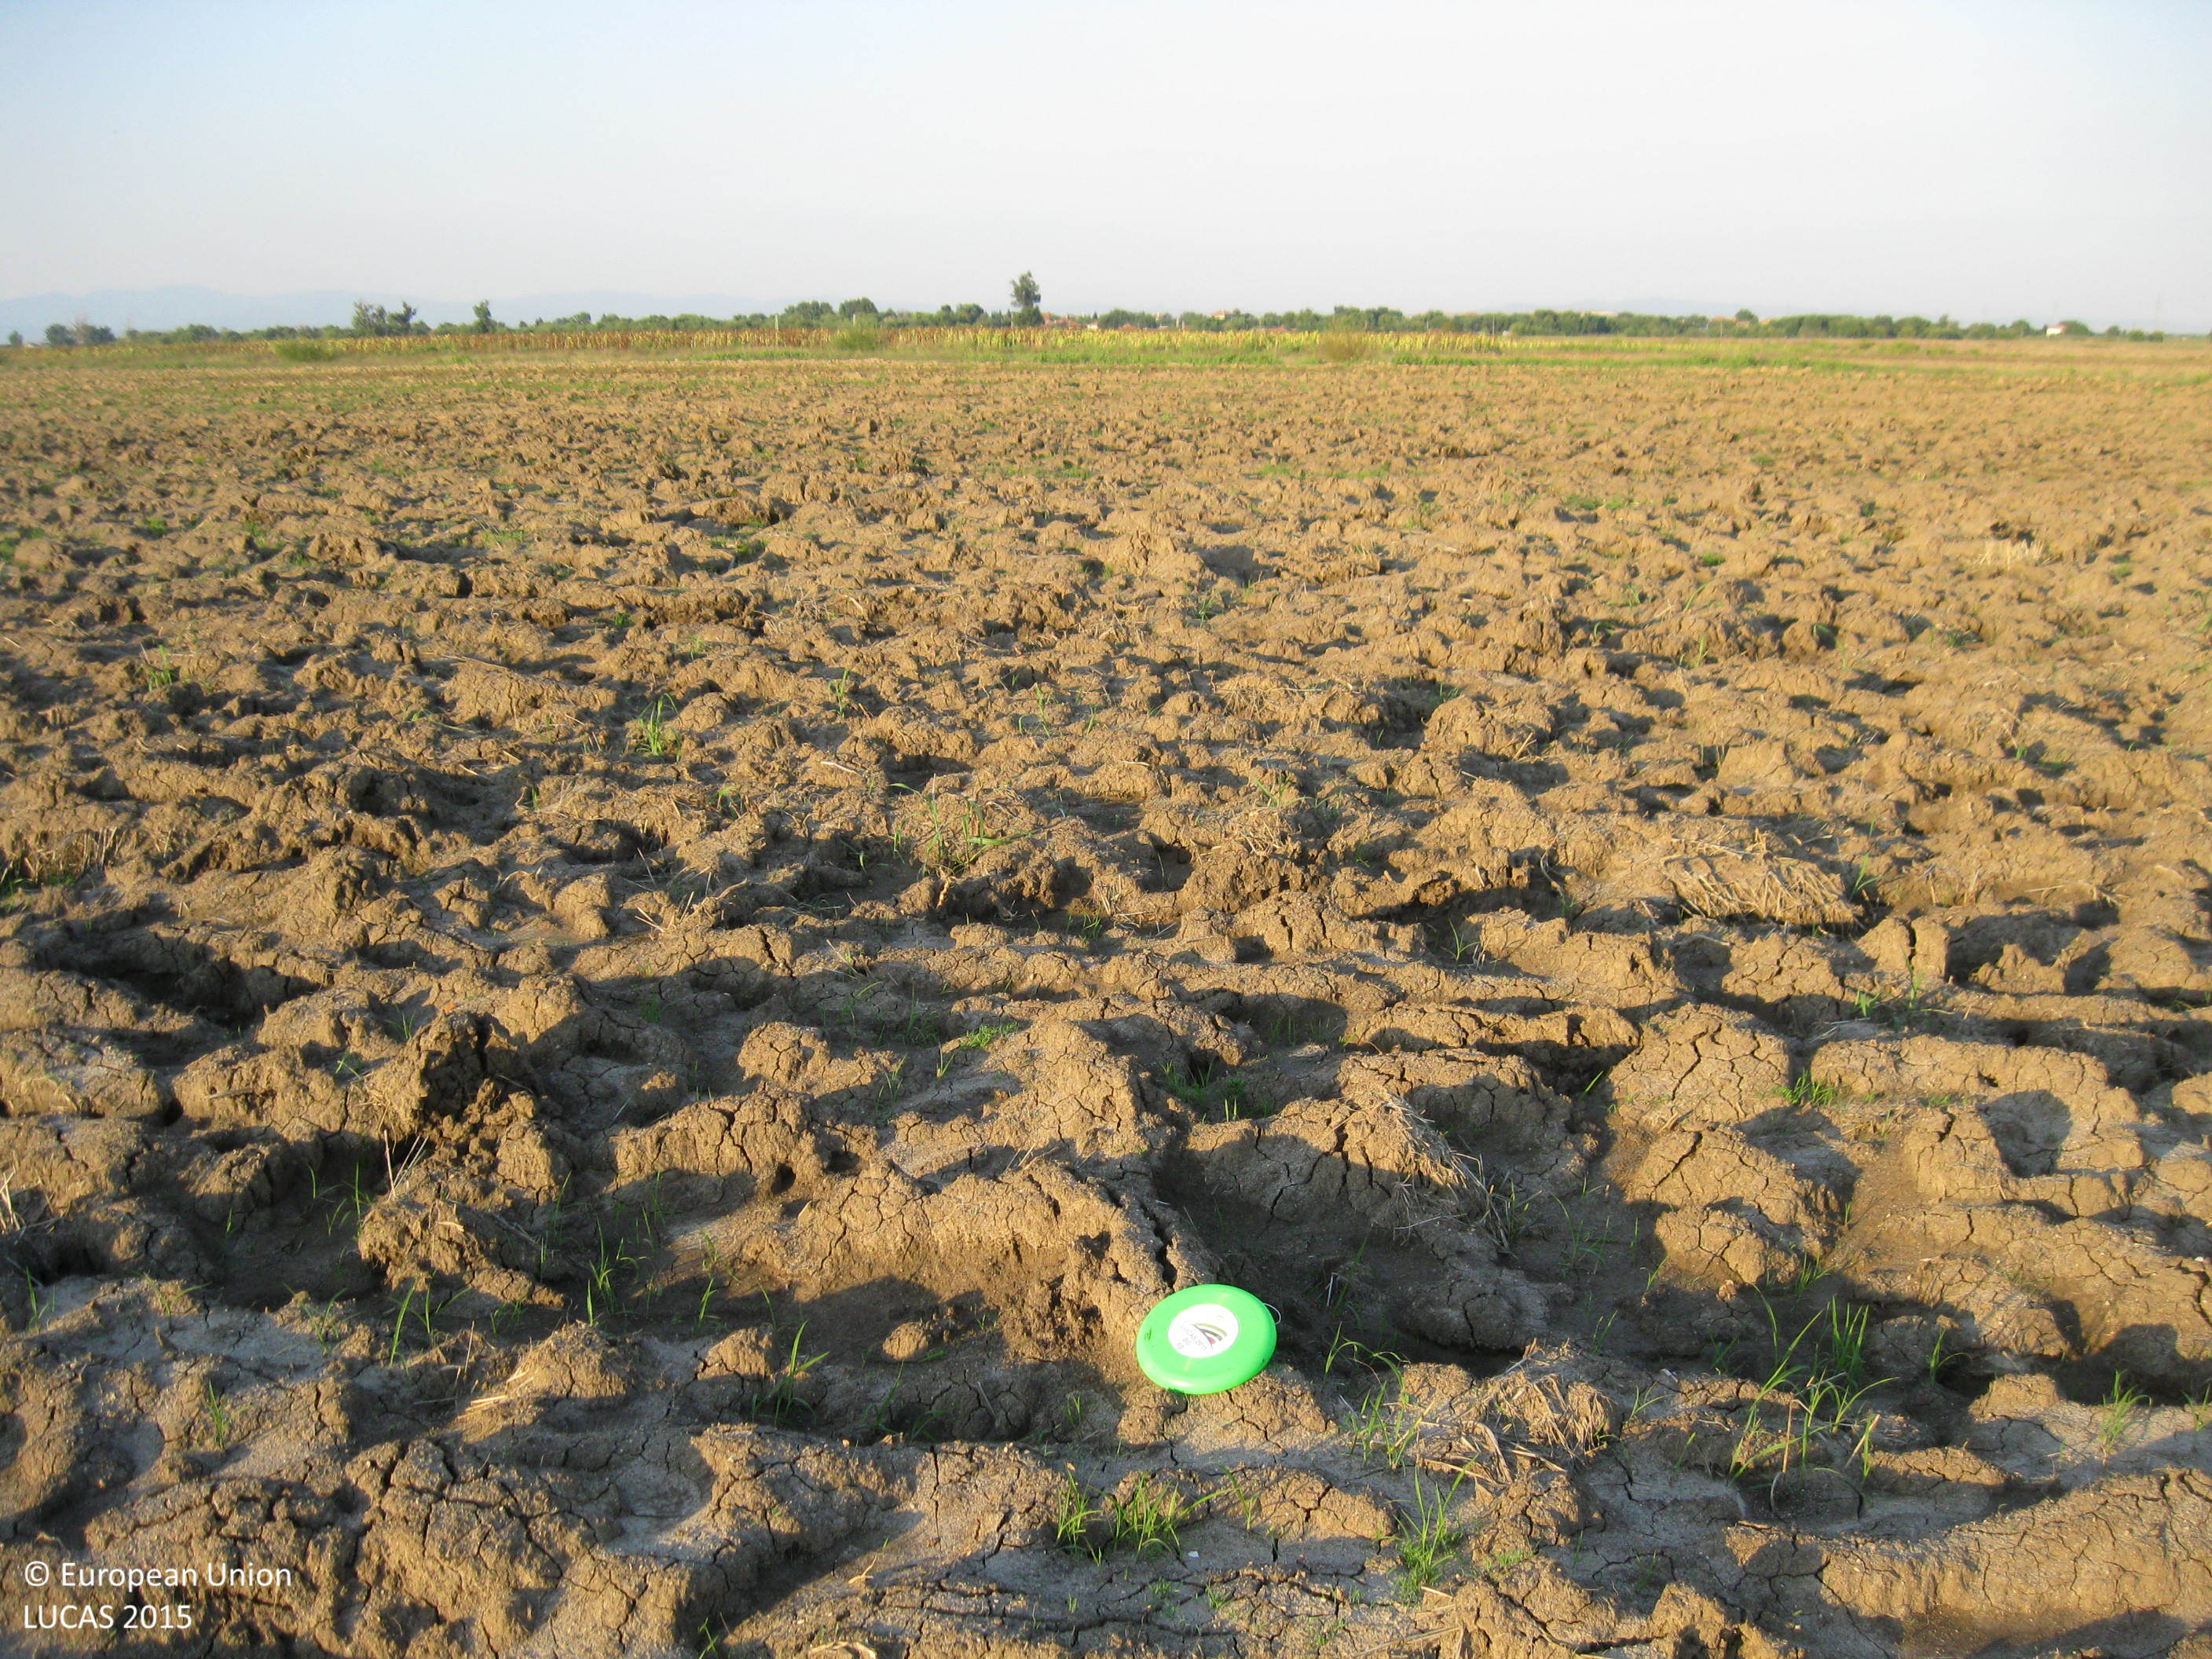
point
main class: Cropland
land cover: Common wheat
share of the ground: < 10 %
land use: Agriculture (excluding fallow land and kitchen gardens)
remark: Harvested field
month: August
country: BG
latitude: 42.1989
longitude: 24.9395
